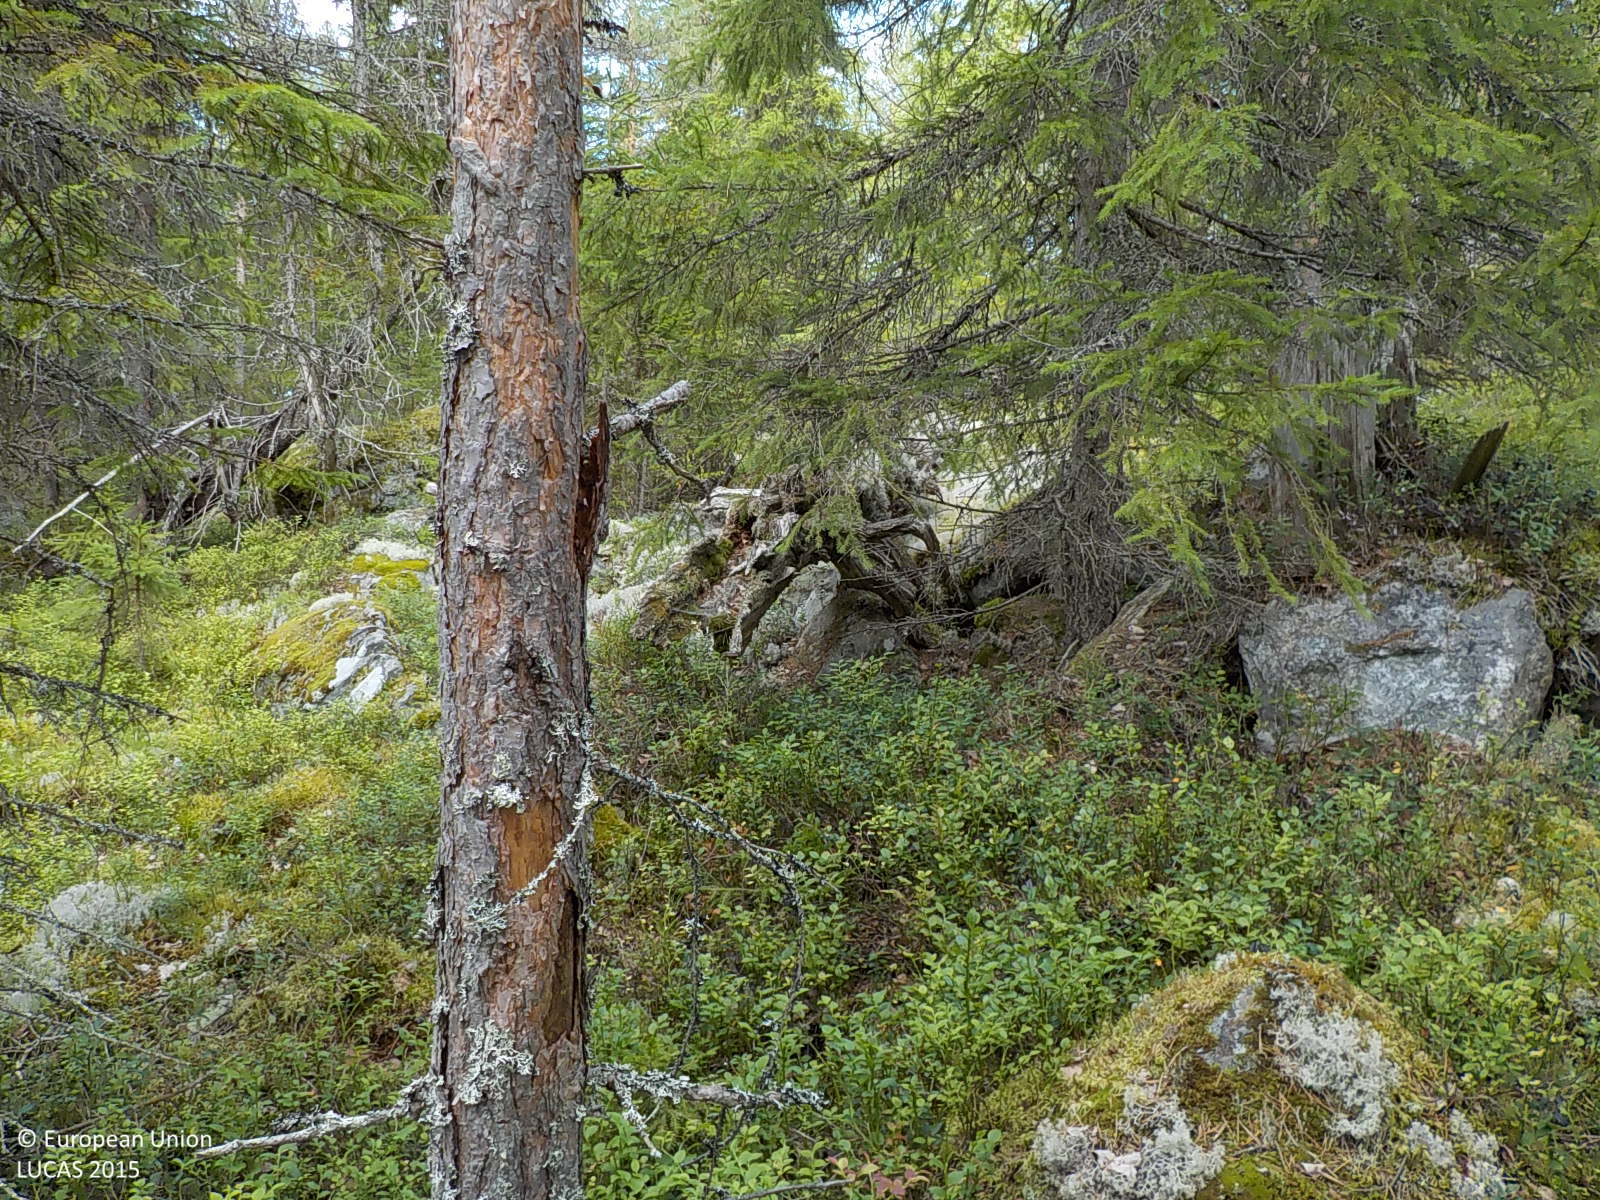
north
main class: Woodland
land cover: Pine dominated coniferous woodland
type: boreal forest
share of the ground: > 75 %
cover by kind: coniferous forest trees 80 %, shrubs 10 %, broadleaved forest trees 5 %, lichens and mosses 5 %
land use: Forestry
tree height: > 5 m
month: September
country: SE
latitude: 63.2443
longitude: 17.8008
